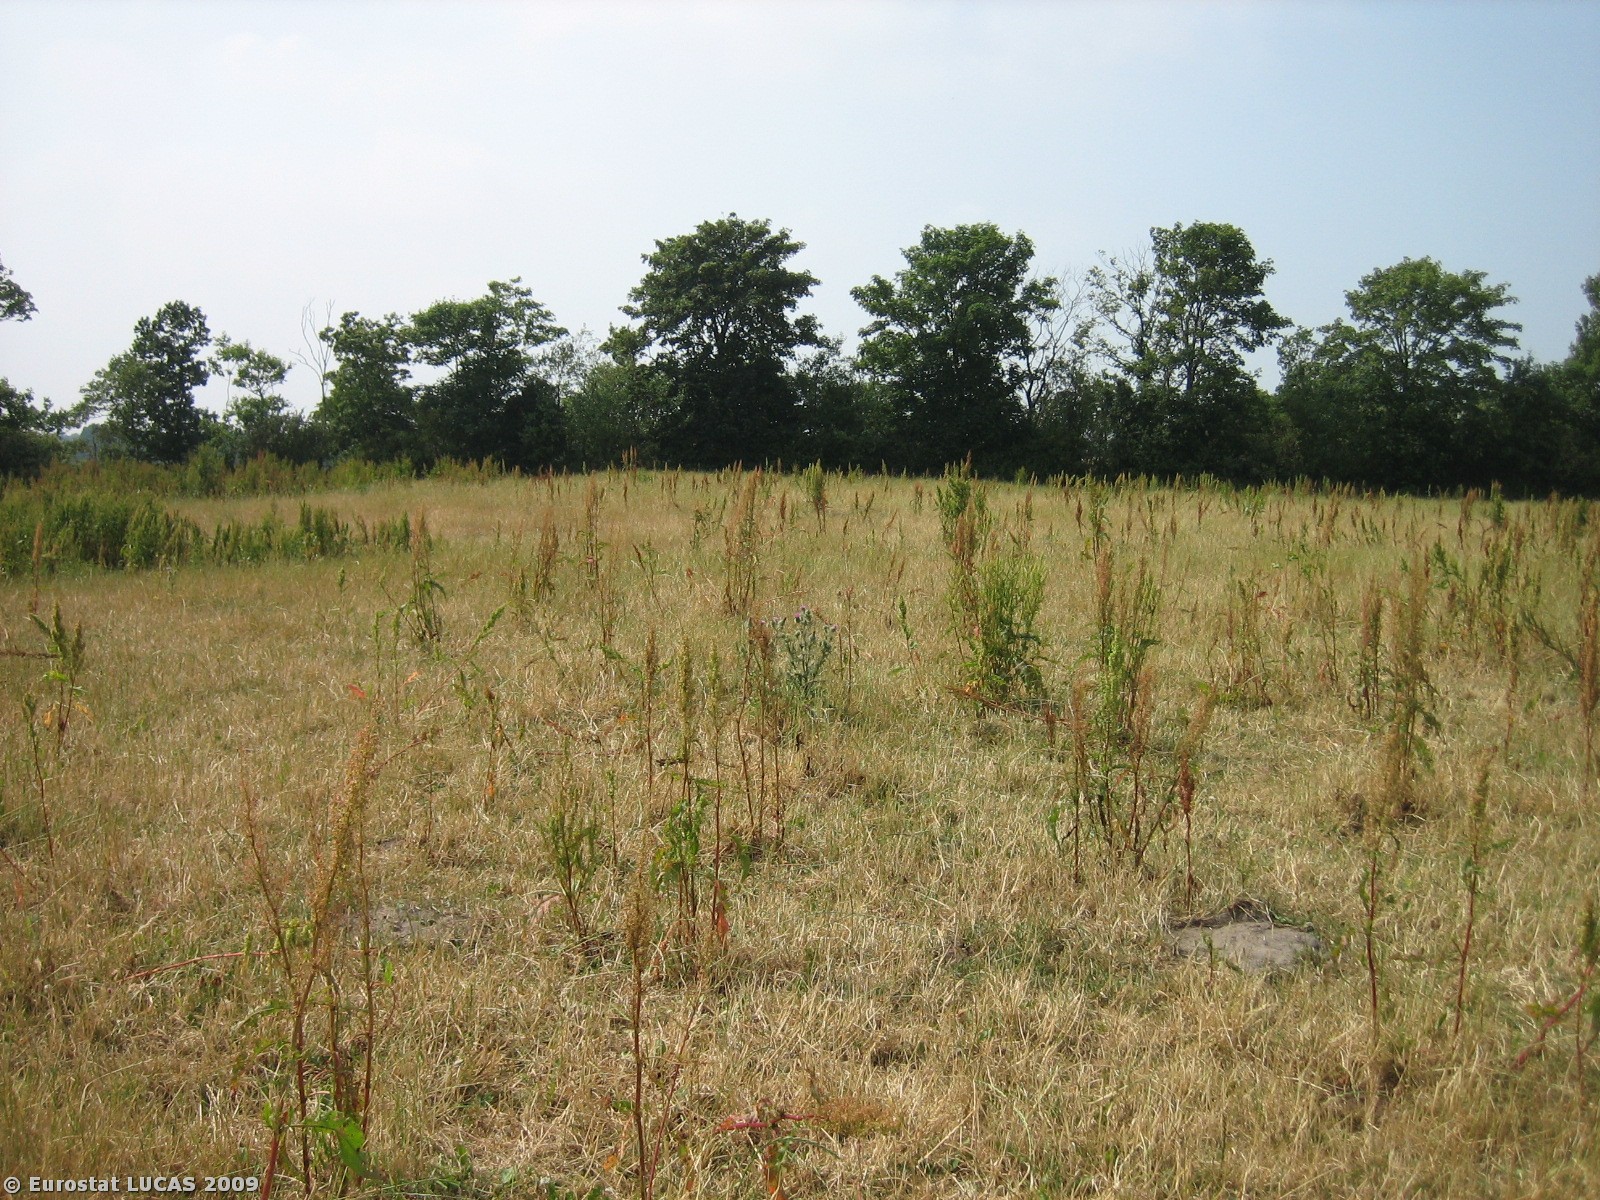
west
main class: Grassland
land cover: Grassland without tree/shrub cover
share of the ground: > 75 %
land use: Agriculture (excluding fallow land and kitchen gardens)
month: July
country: DK
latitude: 55.5710
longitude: 8.8117
